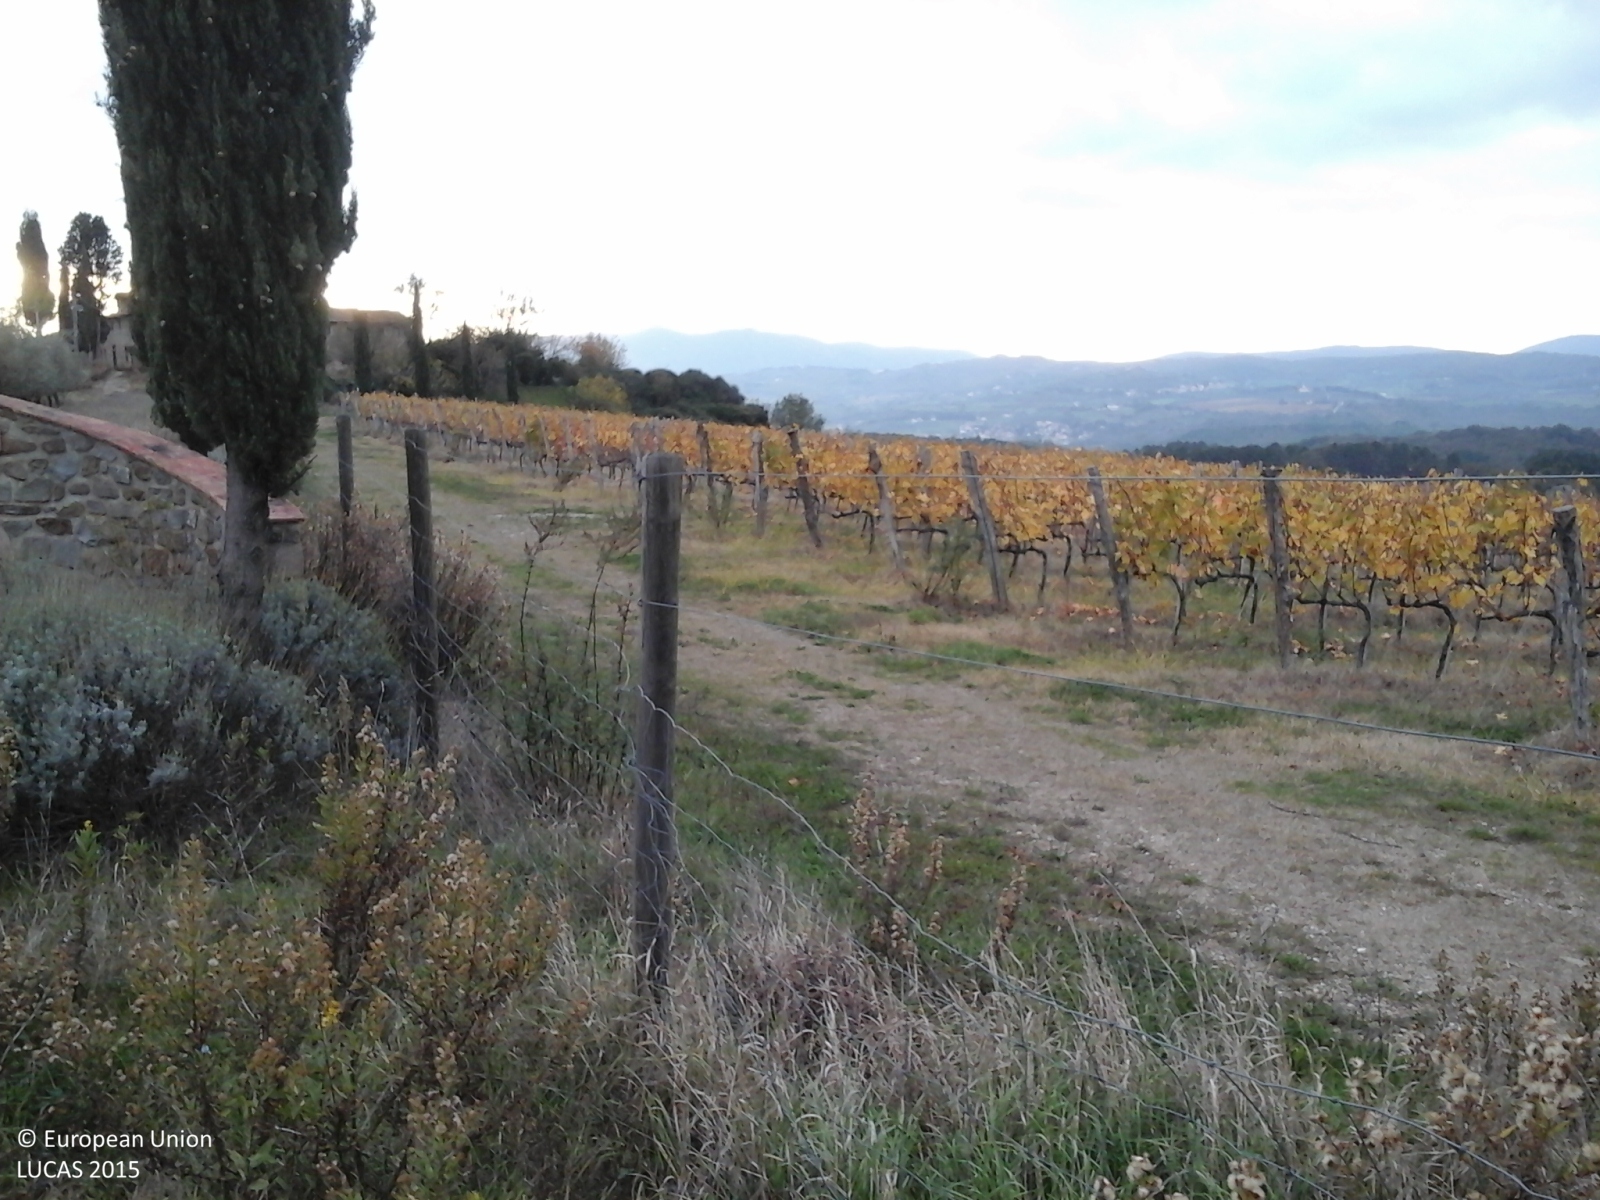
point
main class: Cropland
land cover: Vineyards
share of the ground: 25 - 50 %
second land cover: Grassland without tree/shrub cover
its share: 50 - 75 %
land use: Agriculture (excluding fallow land and kitchen gardens)
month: September
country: IT
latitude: 43.7263
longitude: 11.4982
